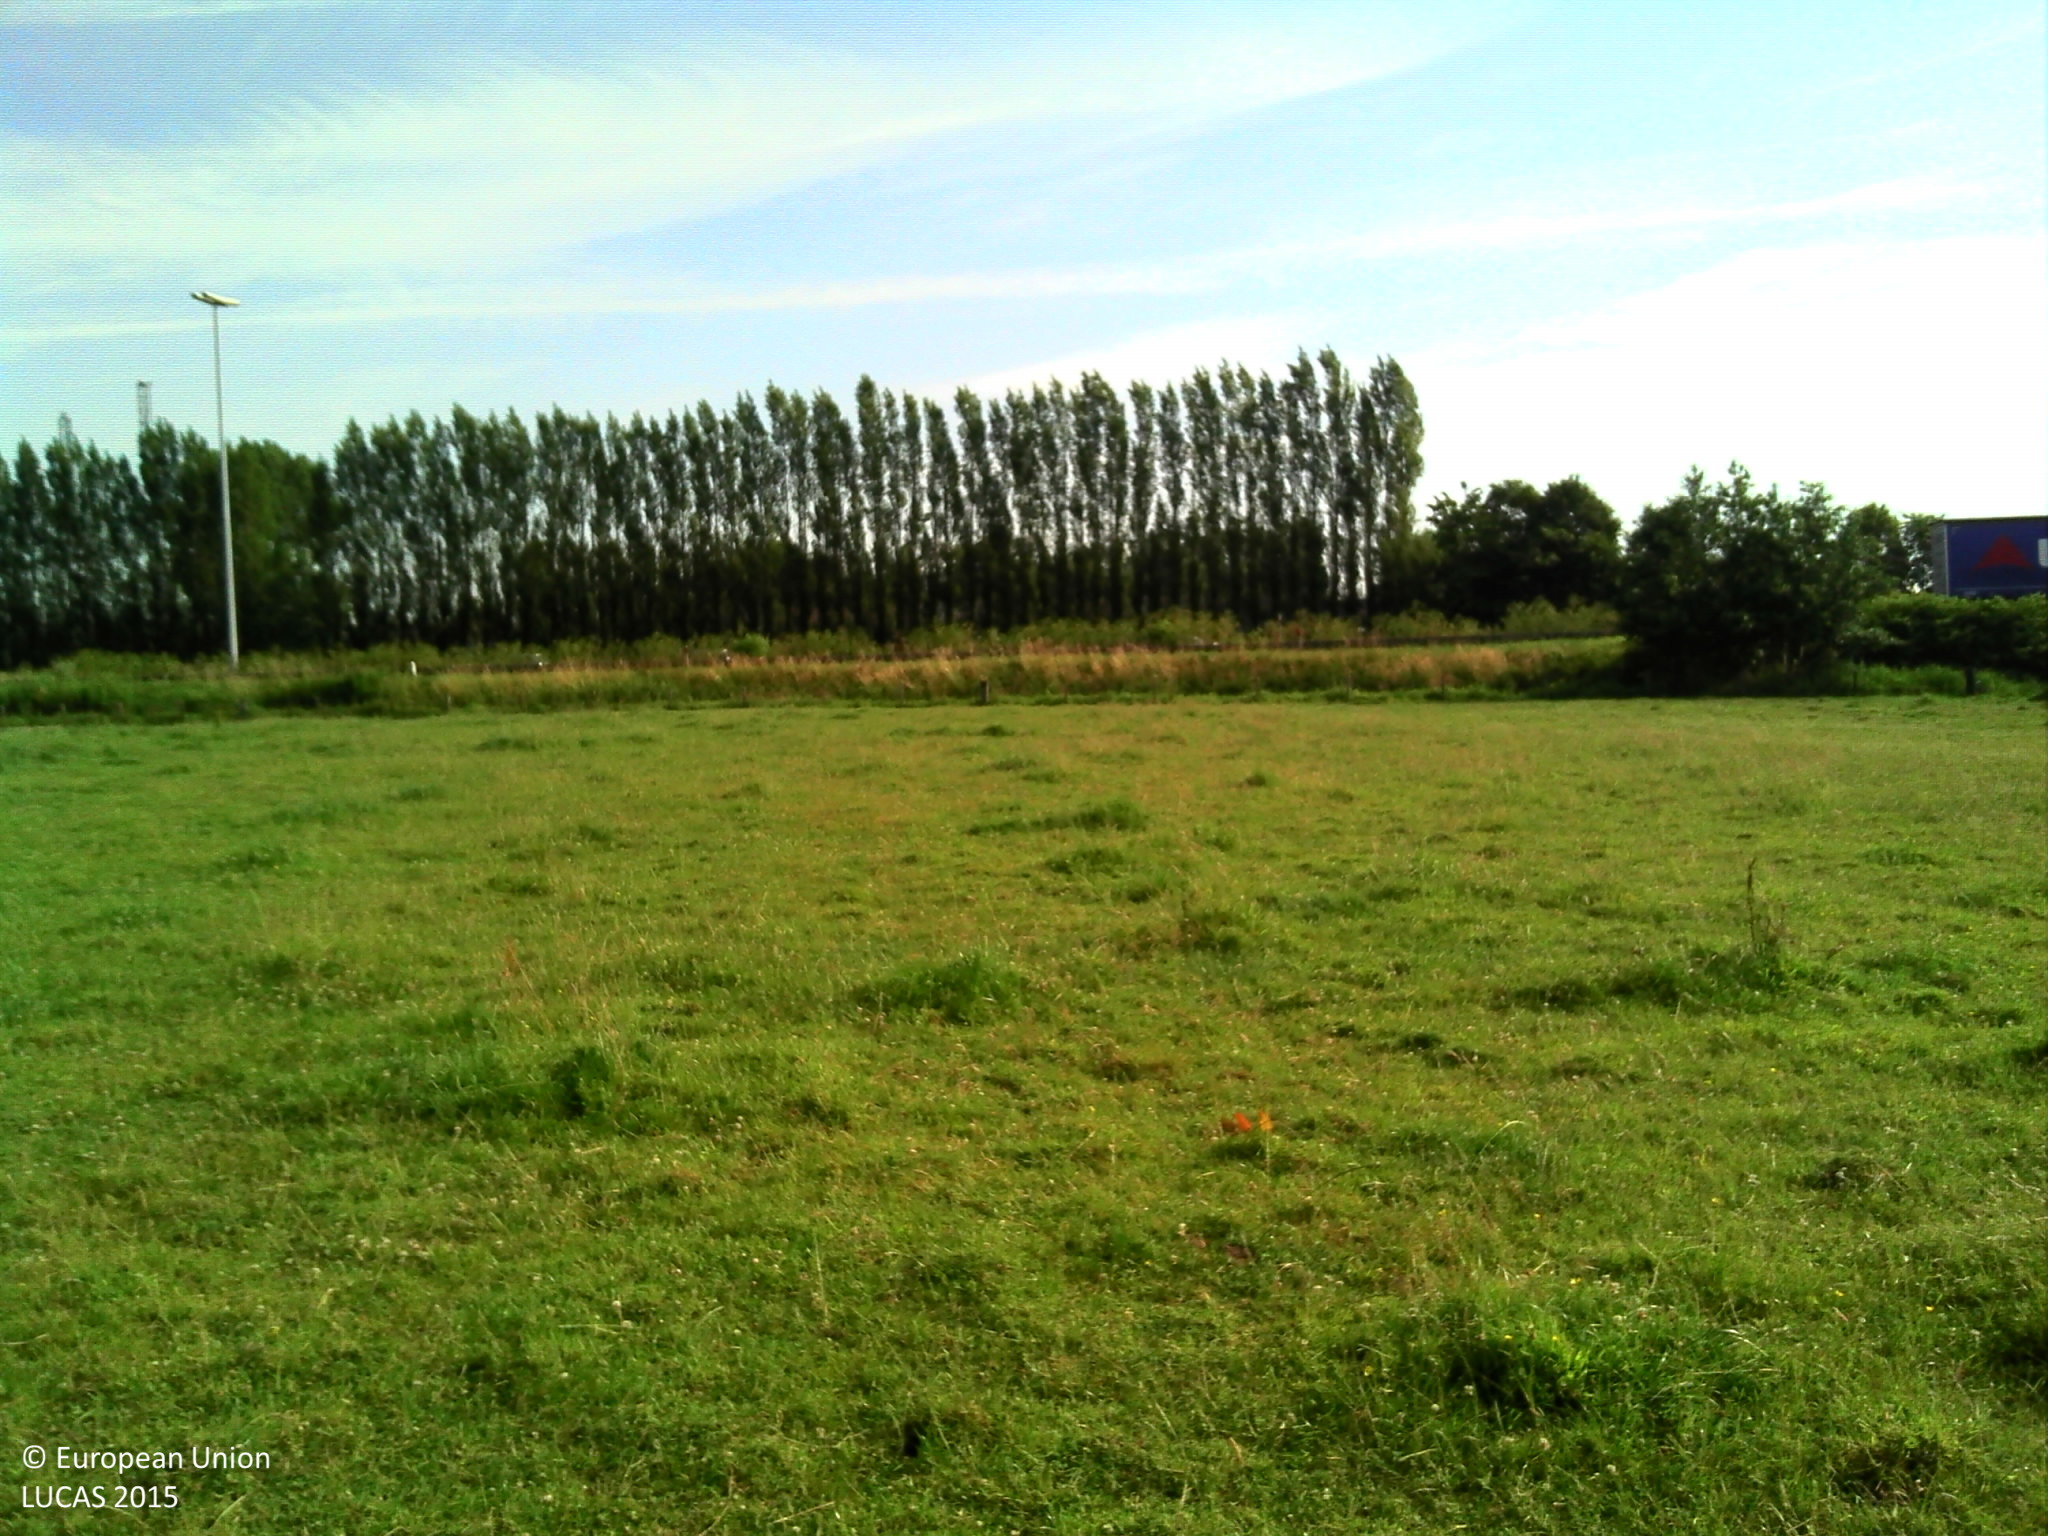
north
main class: Grassland
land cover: Grassland without tree/shrub cover
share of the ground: > 75 %
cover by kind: herbaceous plants 100 %
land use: Agriculture (excluding fallow land and kitchen gardens)
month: July
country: BE
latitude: 51.0777
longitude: 3.4403
